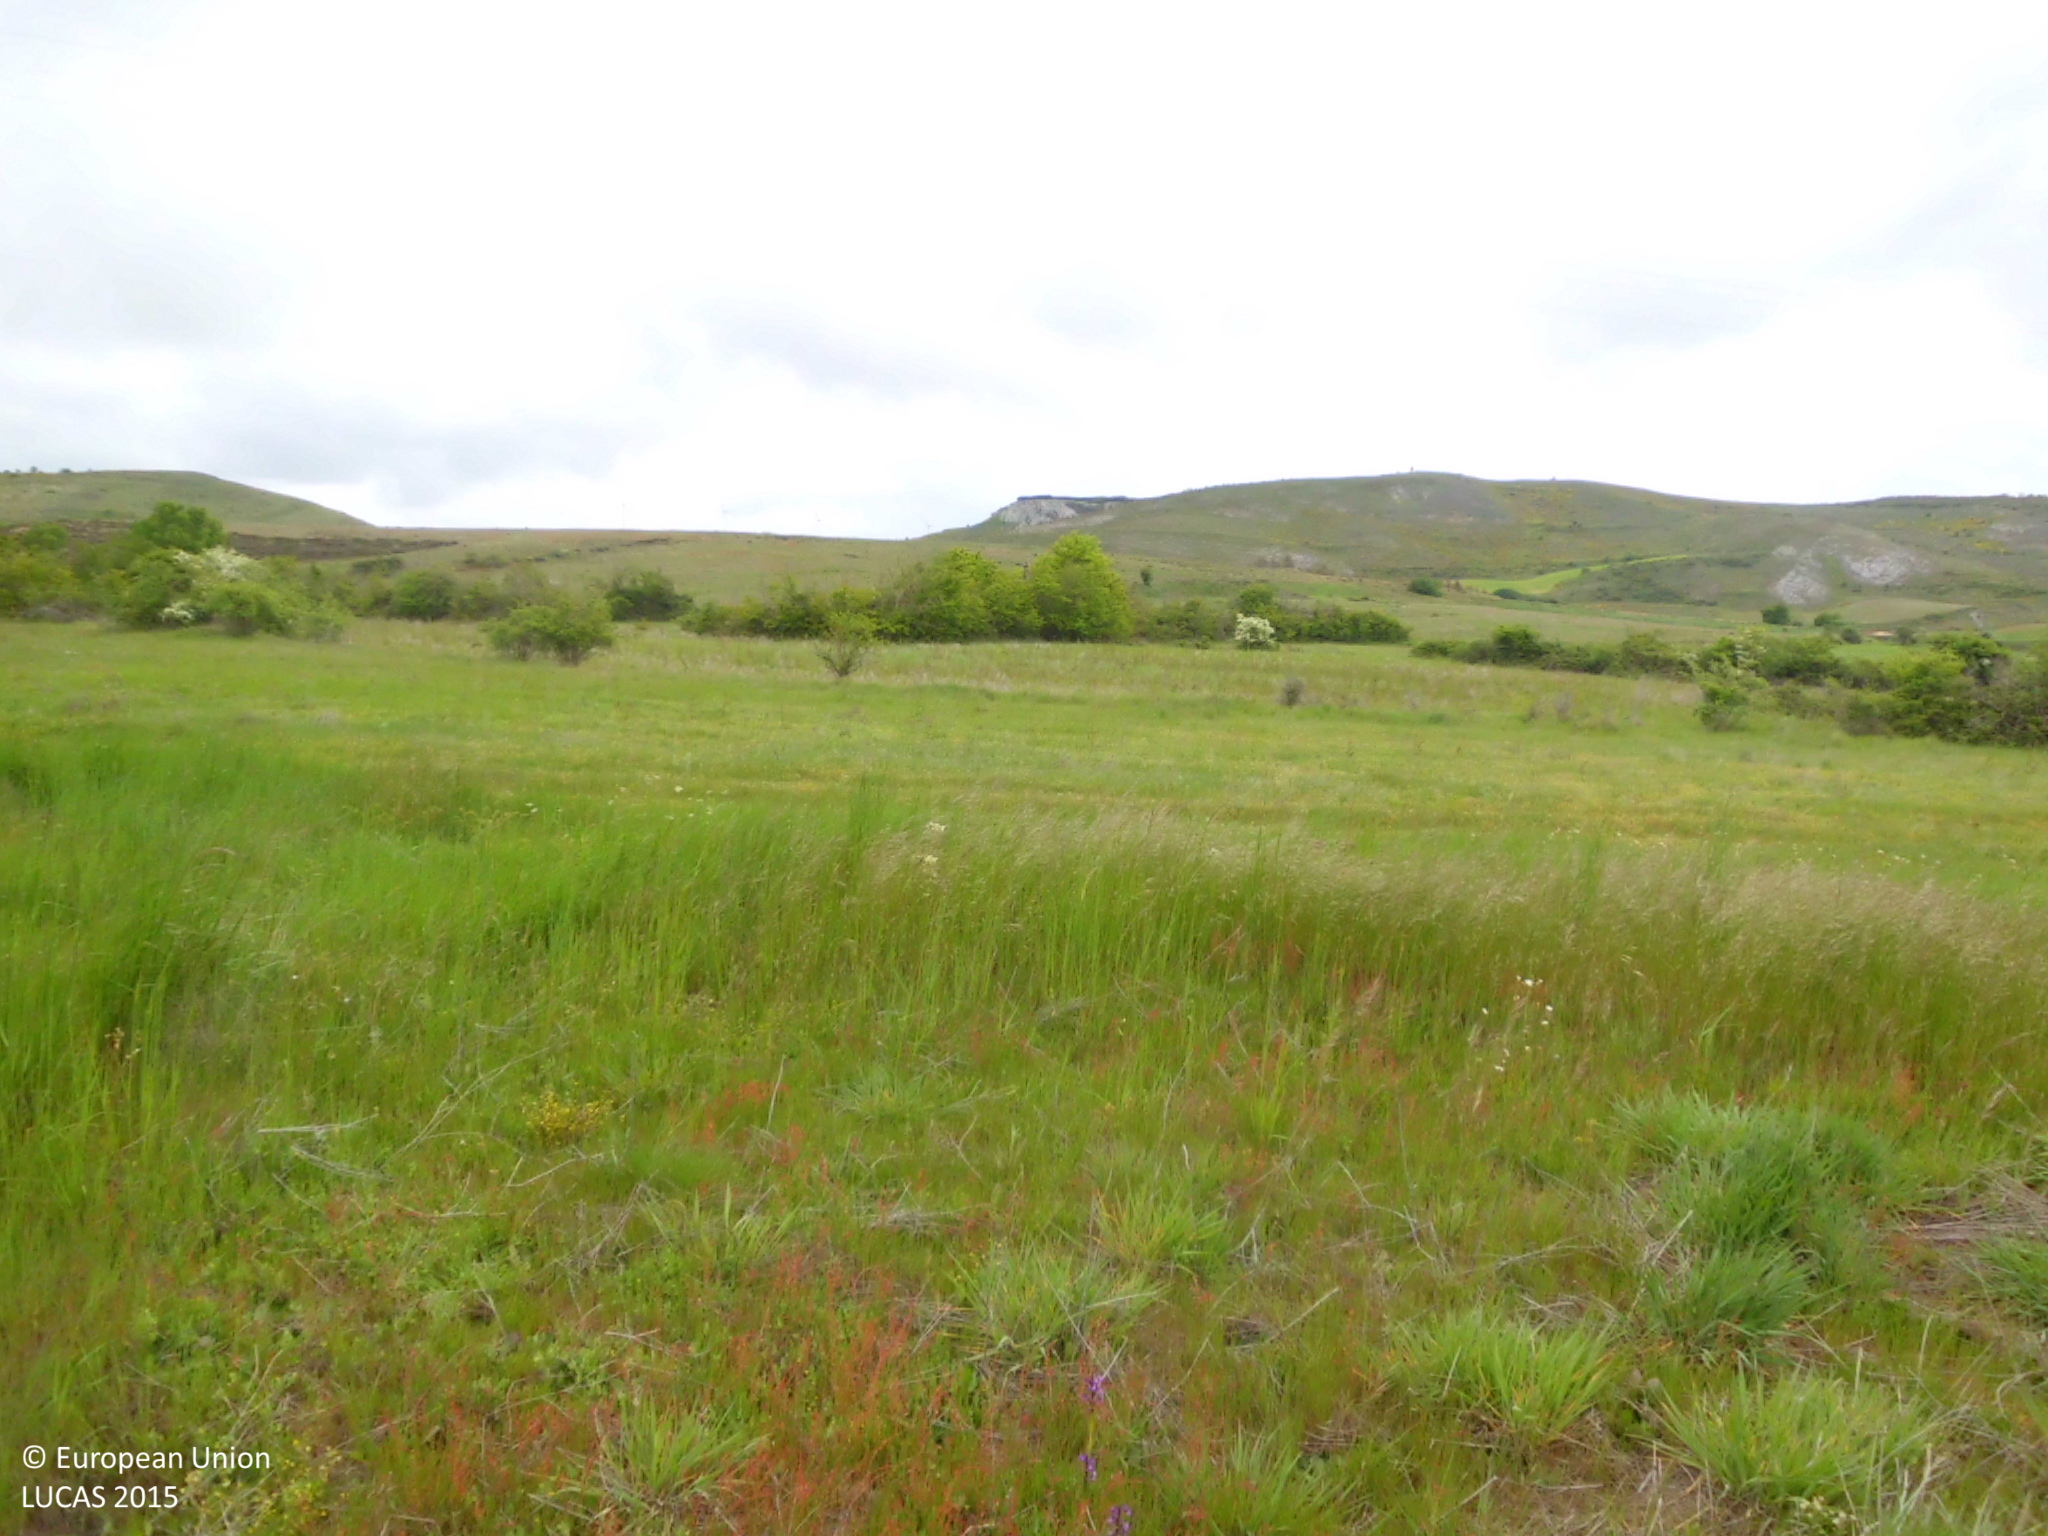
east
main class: Grassland
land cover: Grassland without tree/shrub cover
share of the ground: > 75 %
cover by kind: herbaceous plants 100 %
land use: Agriculture (excluding fallow land and kitchen gardens)
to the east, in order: Grassland without tree/shrub cover; Abandoned hedges; Grassland without tree/shrub cover
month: May
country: ES
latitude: 42.5840
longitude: -3.9208
